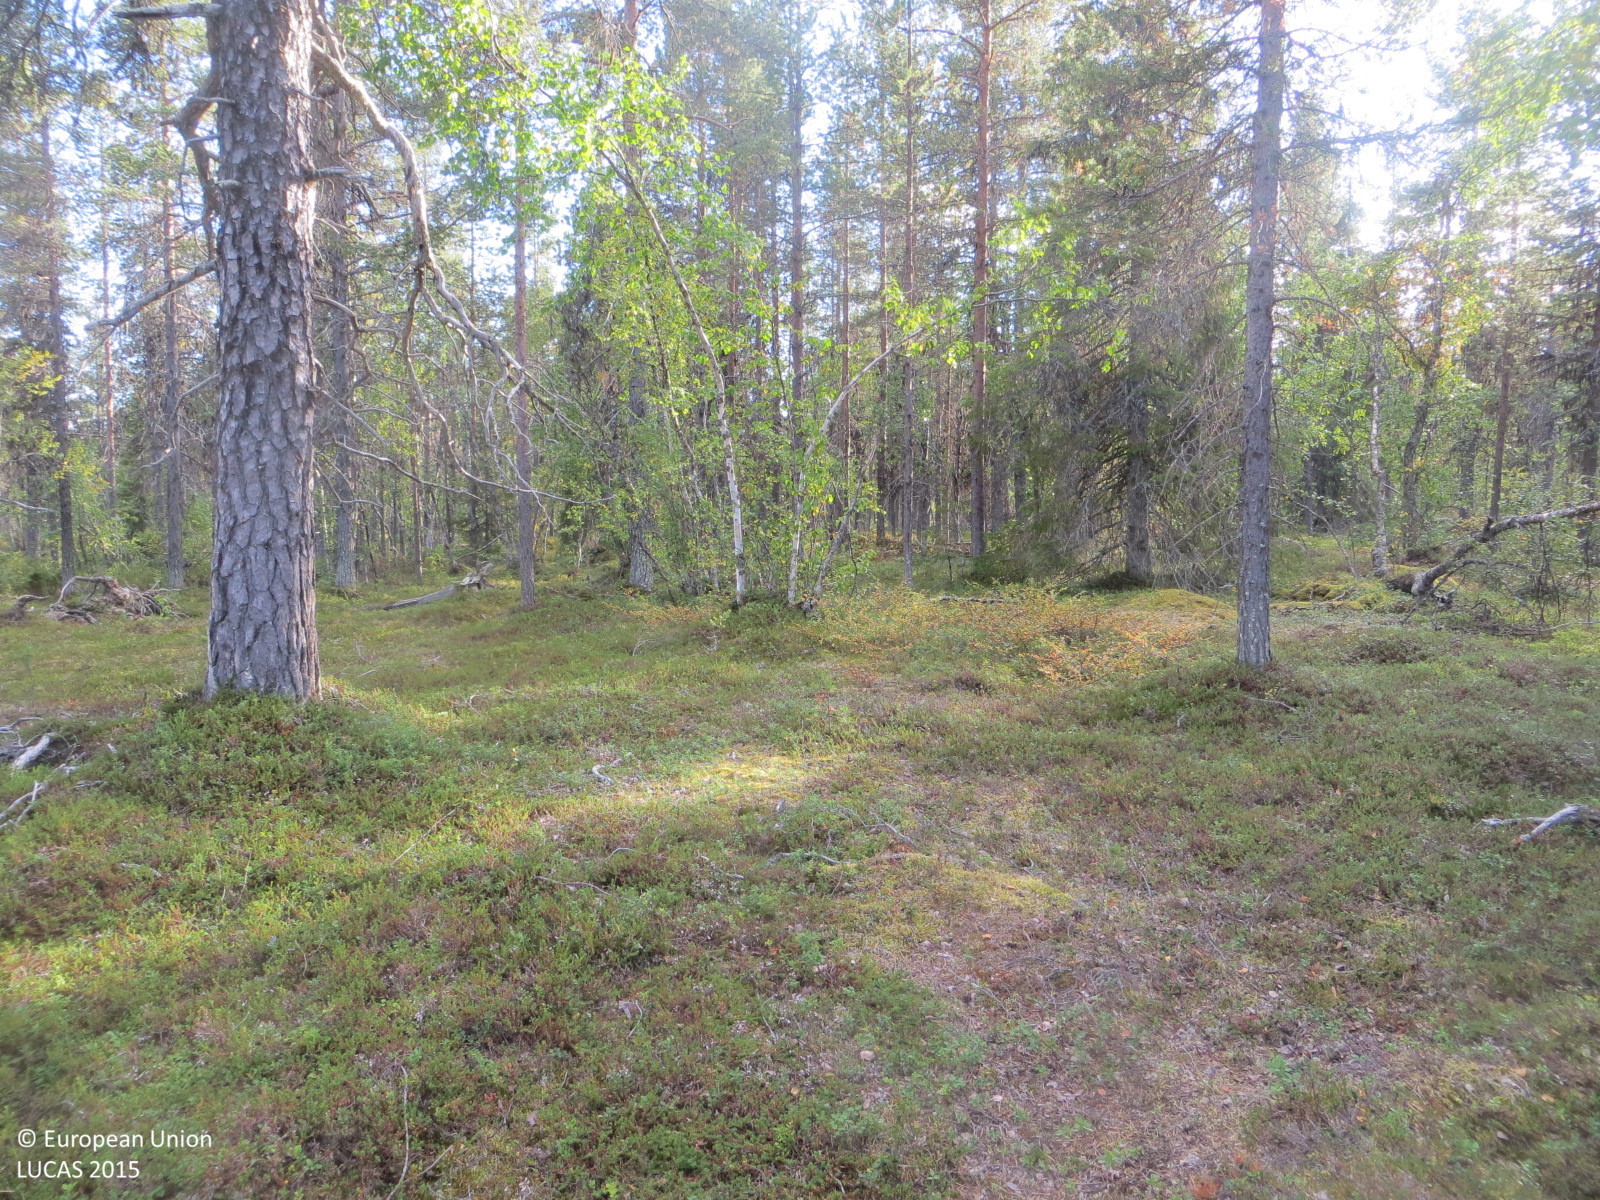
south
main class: Woodland
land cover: Pine dominated coniferous woodland
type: boreal forest
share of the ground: 50 - 75 %
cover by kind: shrubs 50 %, coniferous forest trees 45 %, broadleaved forest trees 5 %
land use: Forestry
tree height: > 5 m
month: August
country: FI
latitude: 68.2123
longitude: 25.6610
